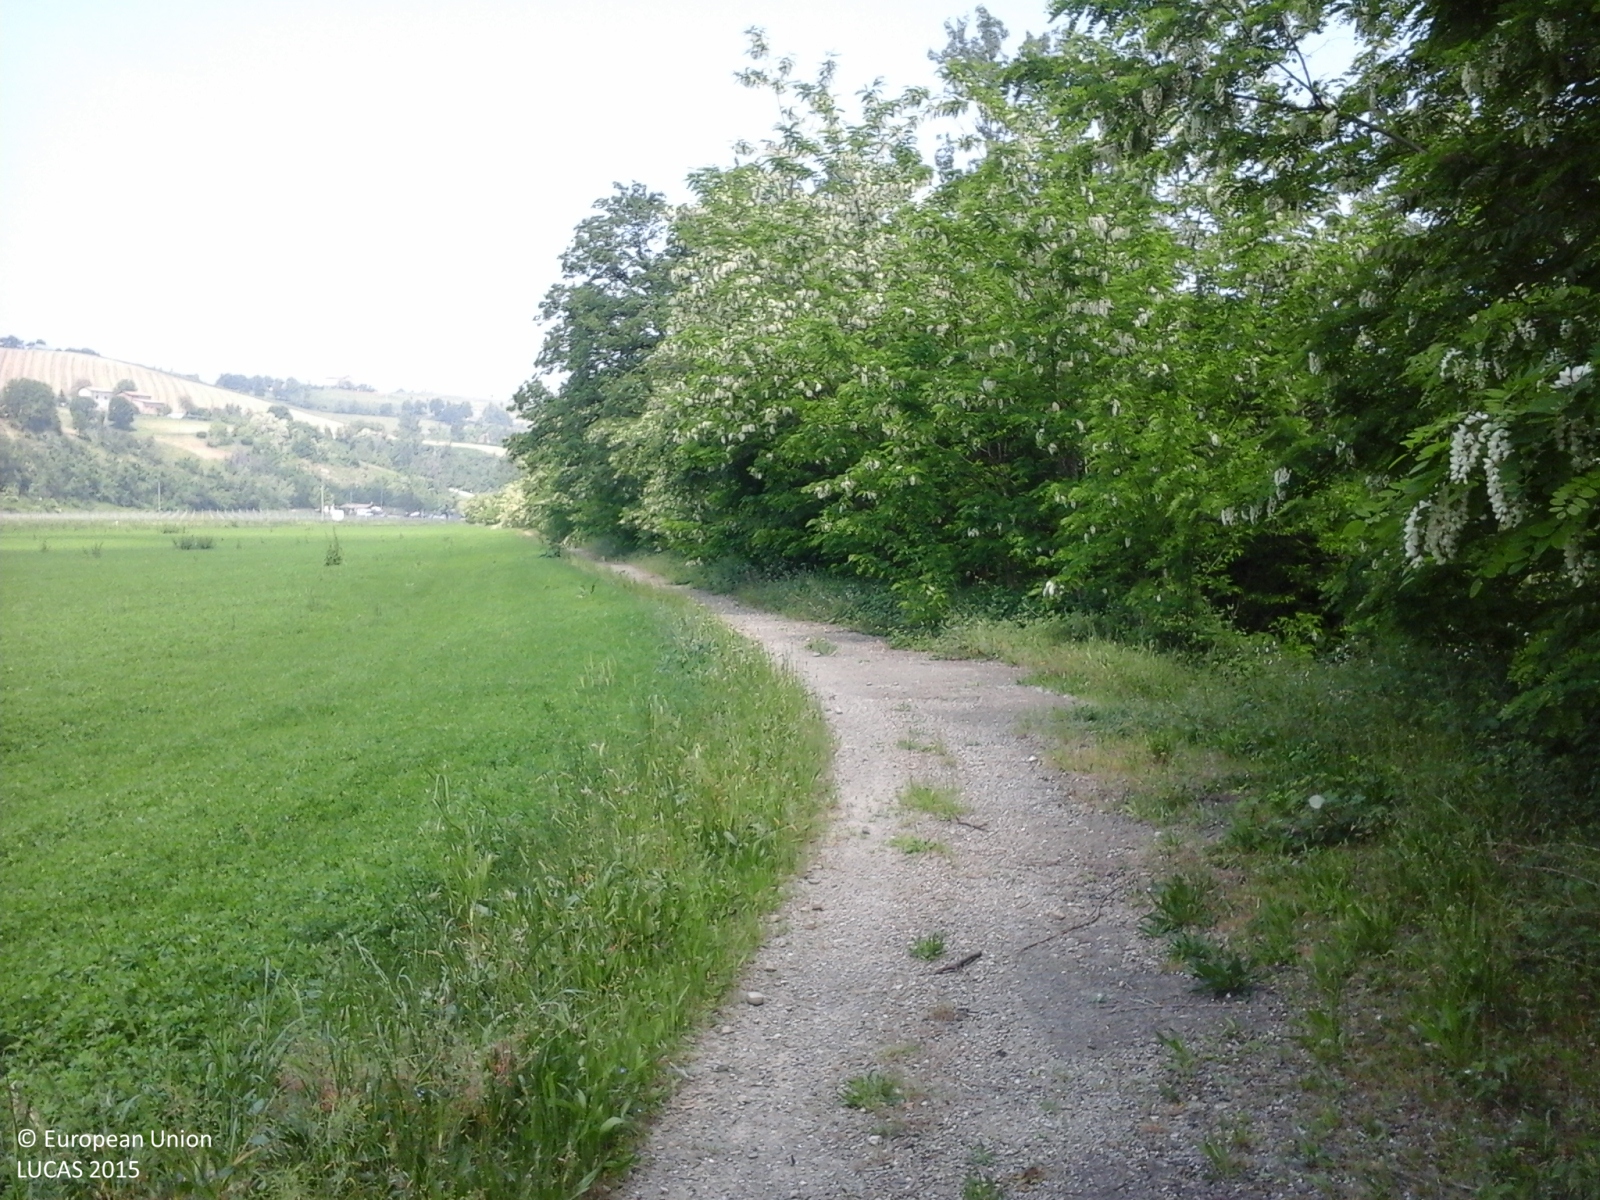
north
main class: Woodland
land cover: Broadleaved woodland
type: mesophytic deciduous forest
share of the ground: > 75 %
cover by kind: broadleaved forest trees 100 %
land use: Semi-natural and natural areas not in use
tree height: > 5 m
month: May
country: IT
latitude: 44.4912
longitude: 10.8658
